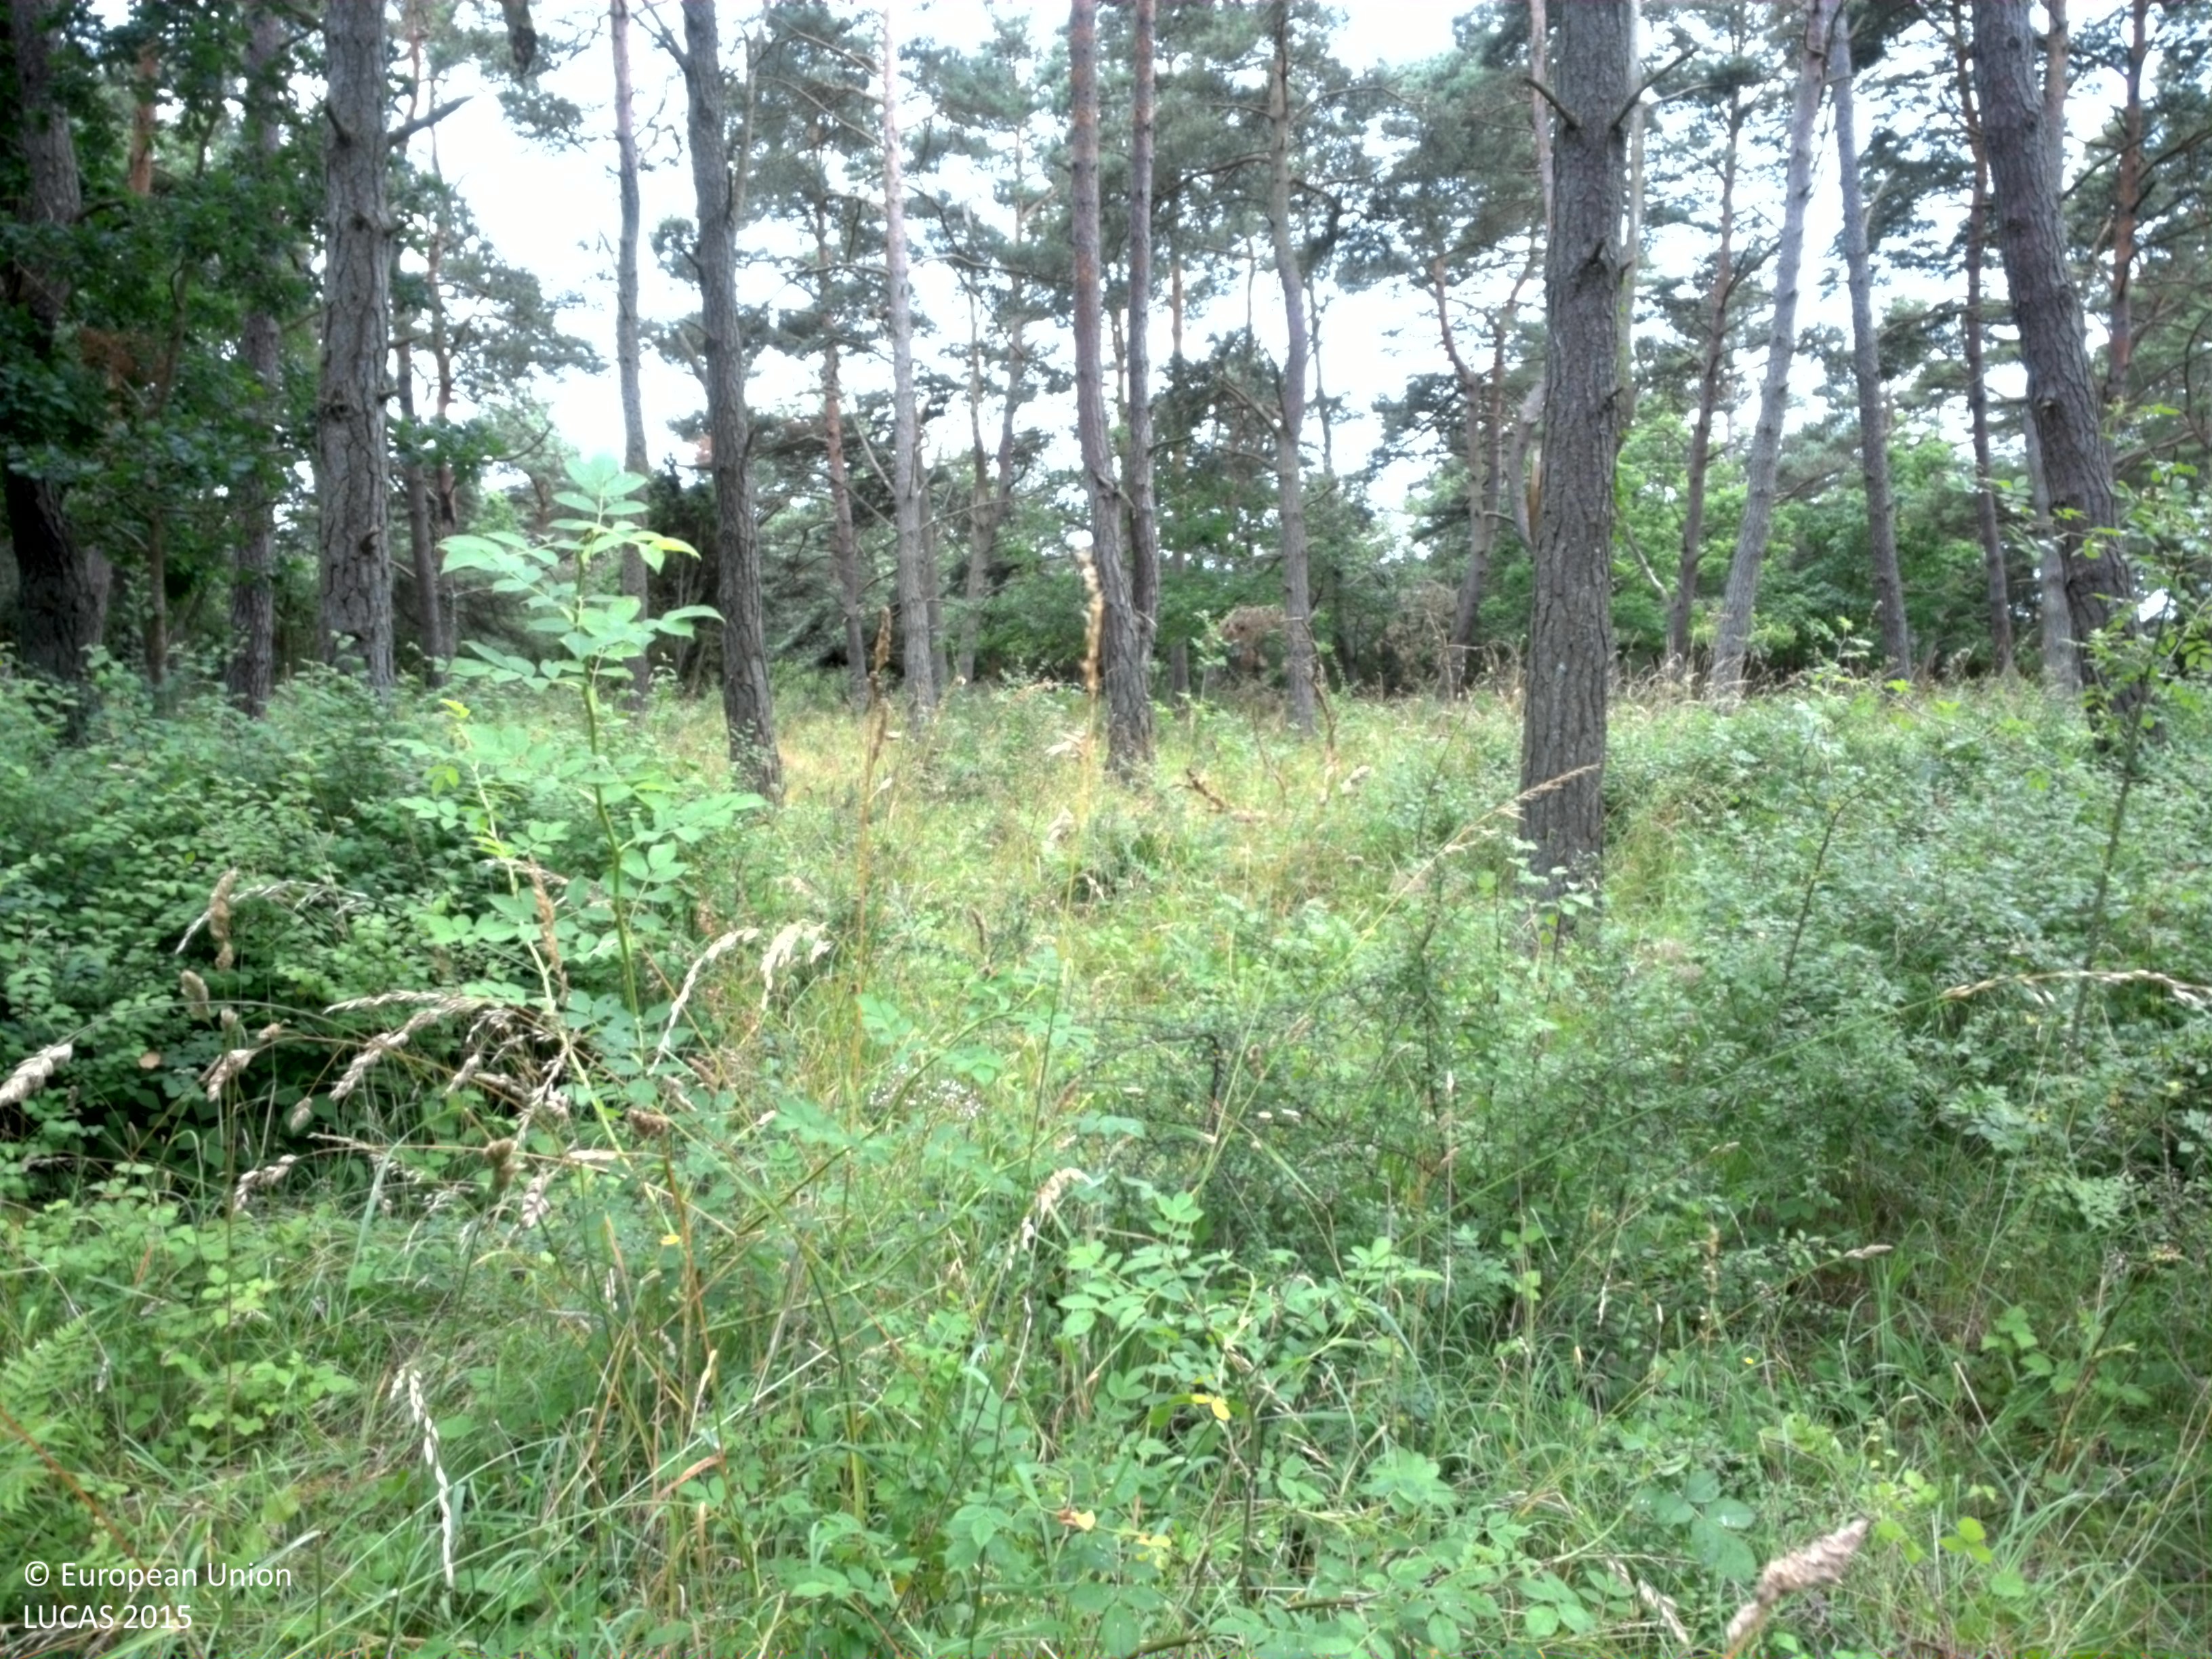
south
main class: Woodland
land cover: Pine dominated coniferous woodland
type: hemiboreal forest and nemoral coniferous forest and mixed broadleaved-coniferous forest
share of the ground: 25 - 50 %
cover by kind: coniferous forest trees 45 %, herbaceous plants 40 %, shrubs 10 %, broadleaved forest trees 5 %
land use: Forestry
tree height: > 5 m
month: July
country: SE
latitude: 57.2684
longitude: 18.6833
